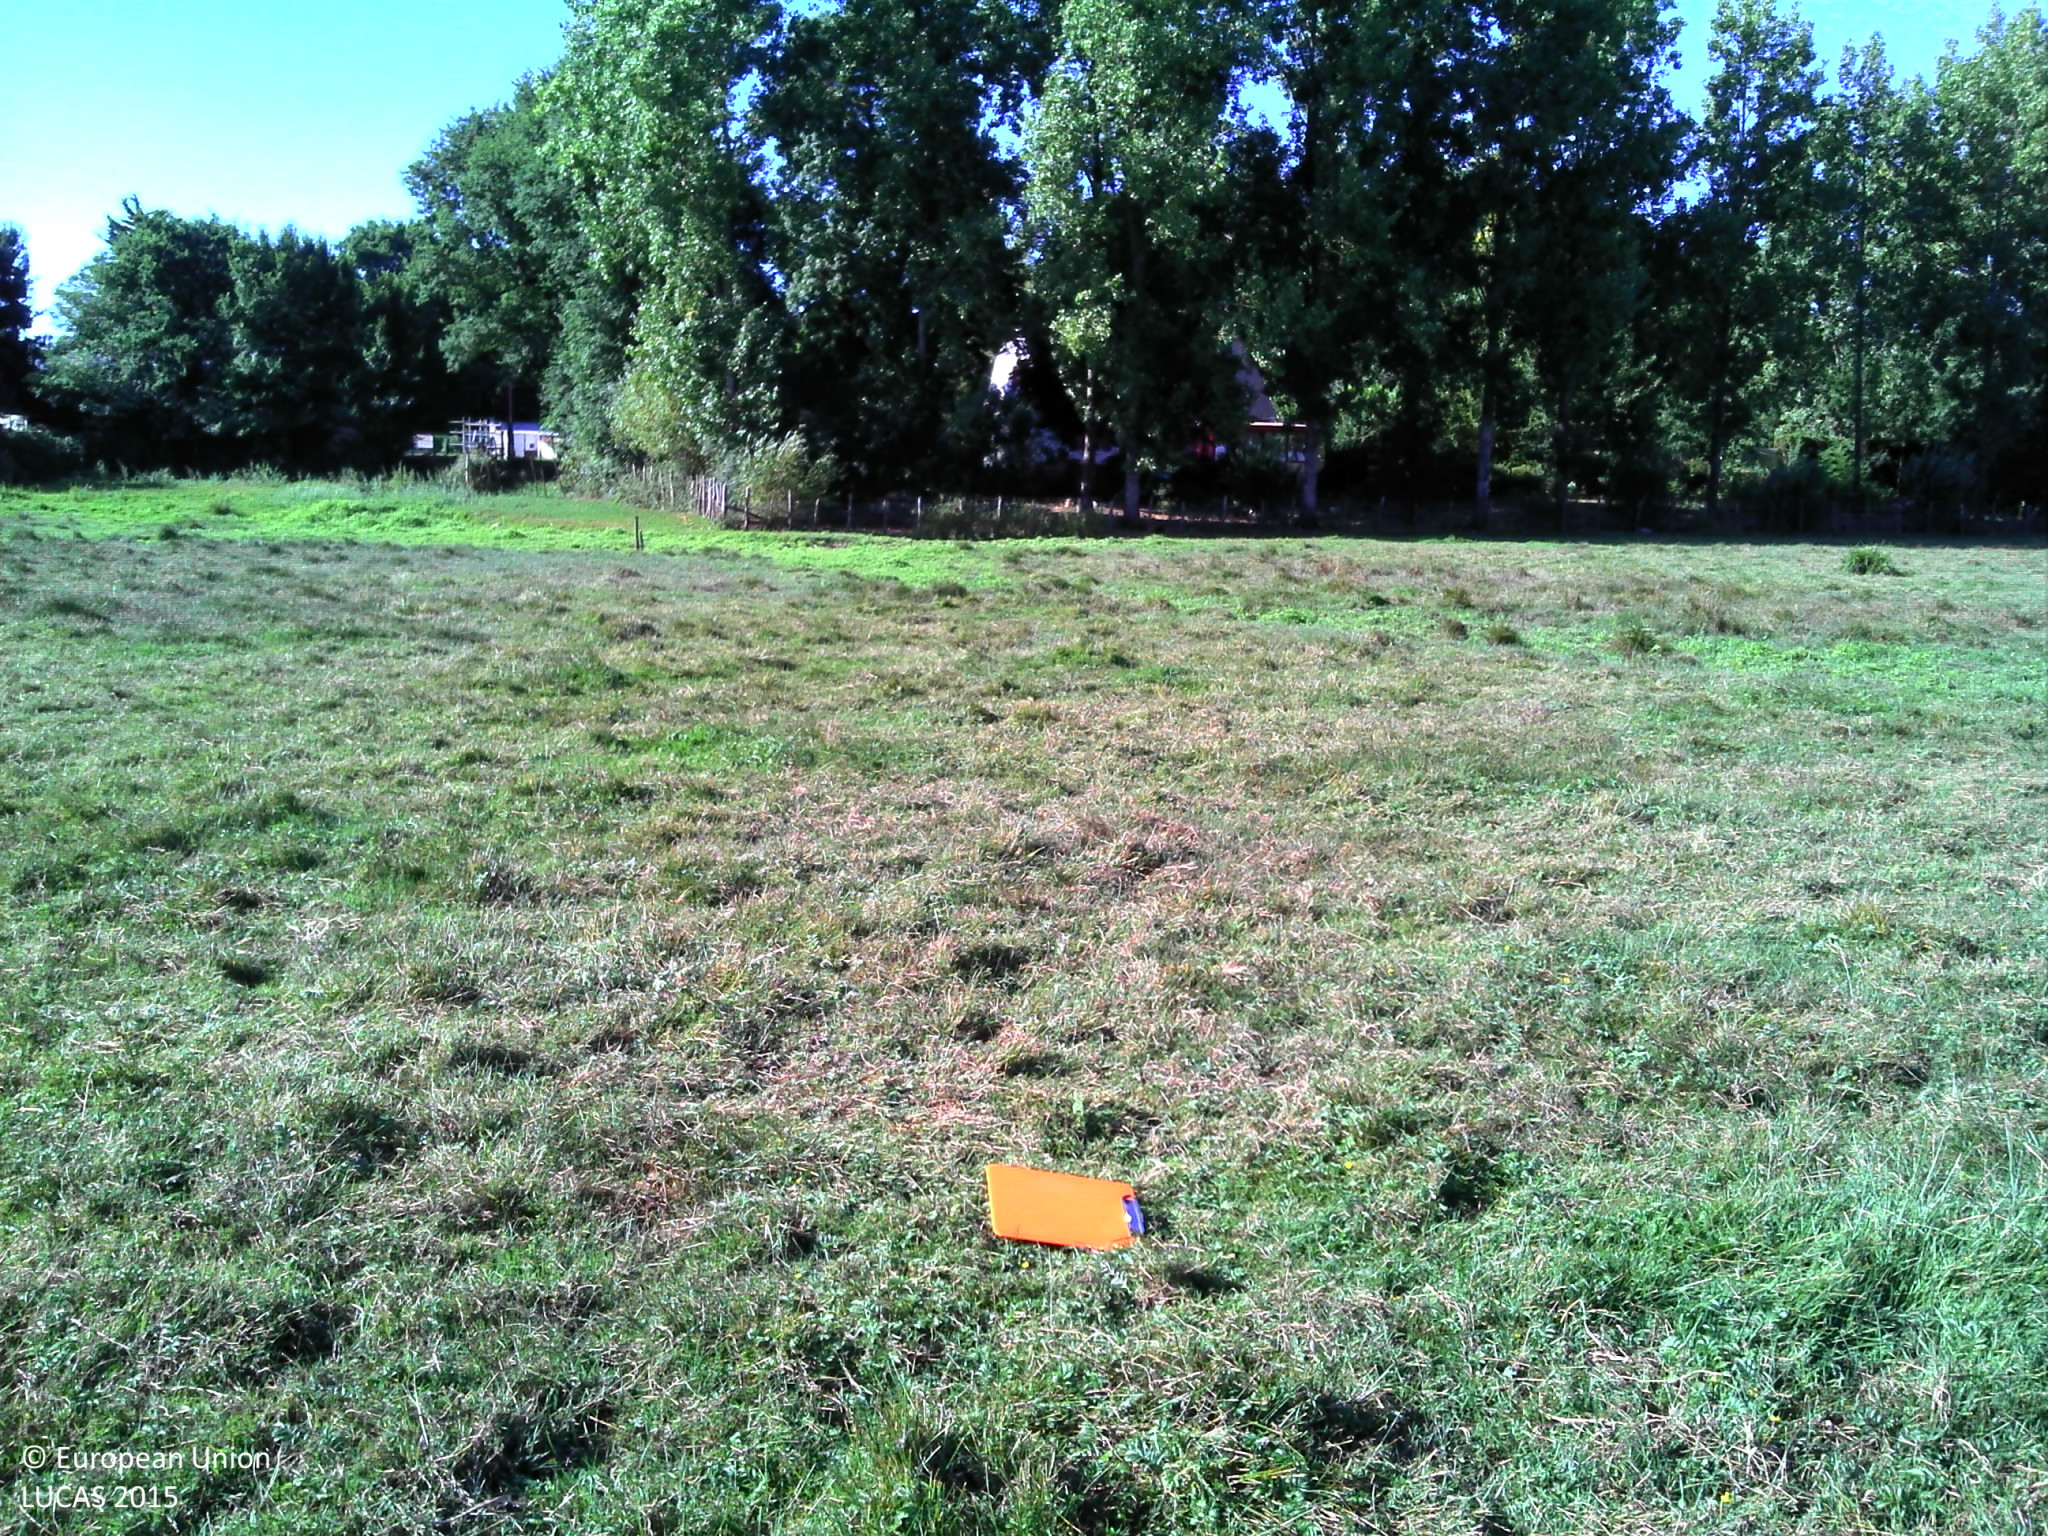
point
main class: Grassland
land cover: Grassland without tree/shrub cover
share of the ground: > 75 %
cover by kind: herbaceous plants 100 %
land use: Agriculture (excluding fallow land and kitchen gardens)
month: July
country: FR
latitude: 47.4090
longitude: -2.0969
